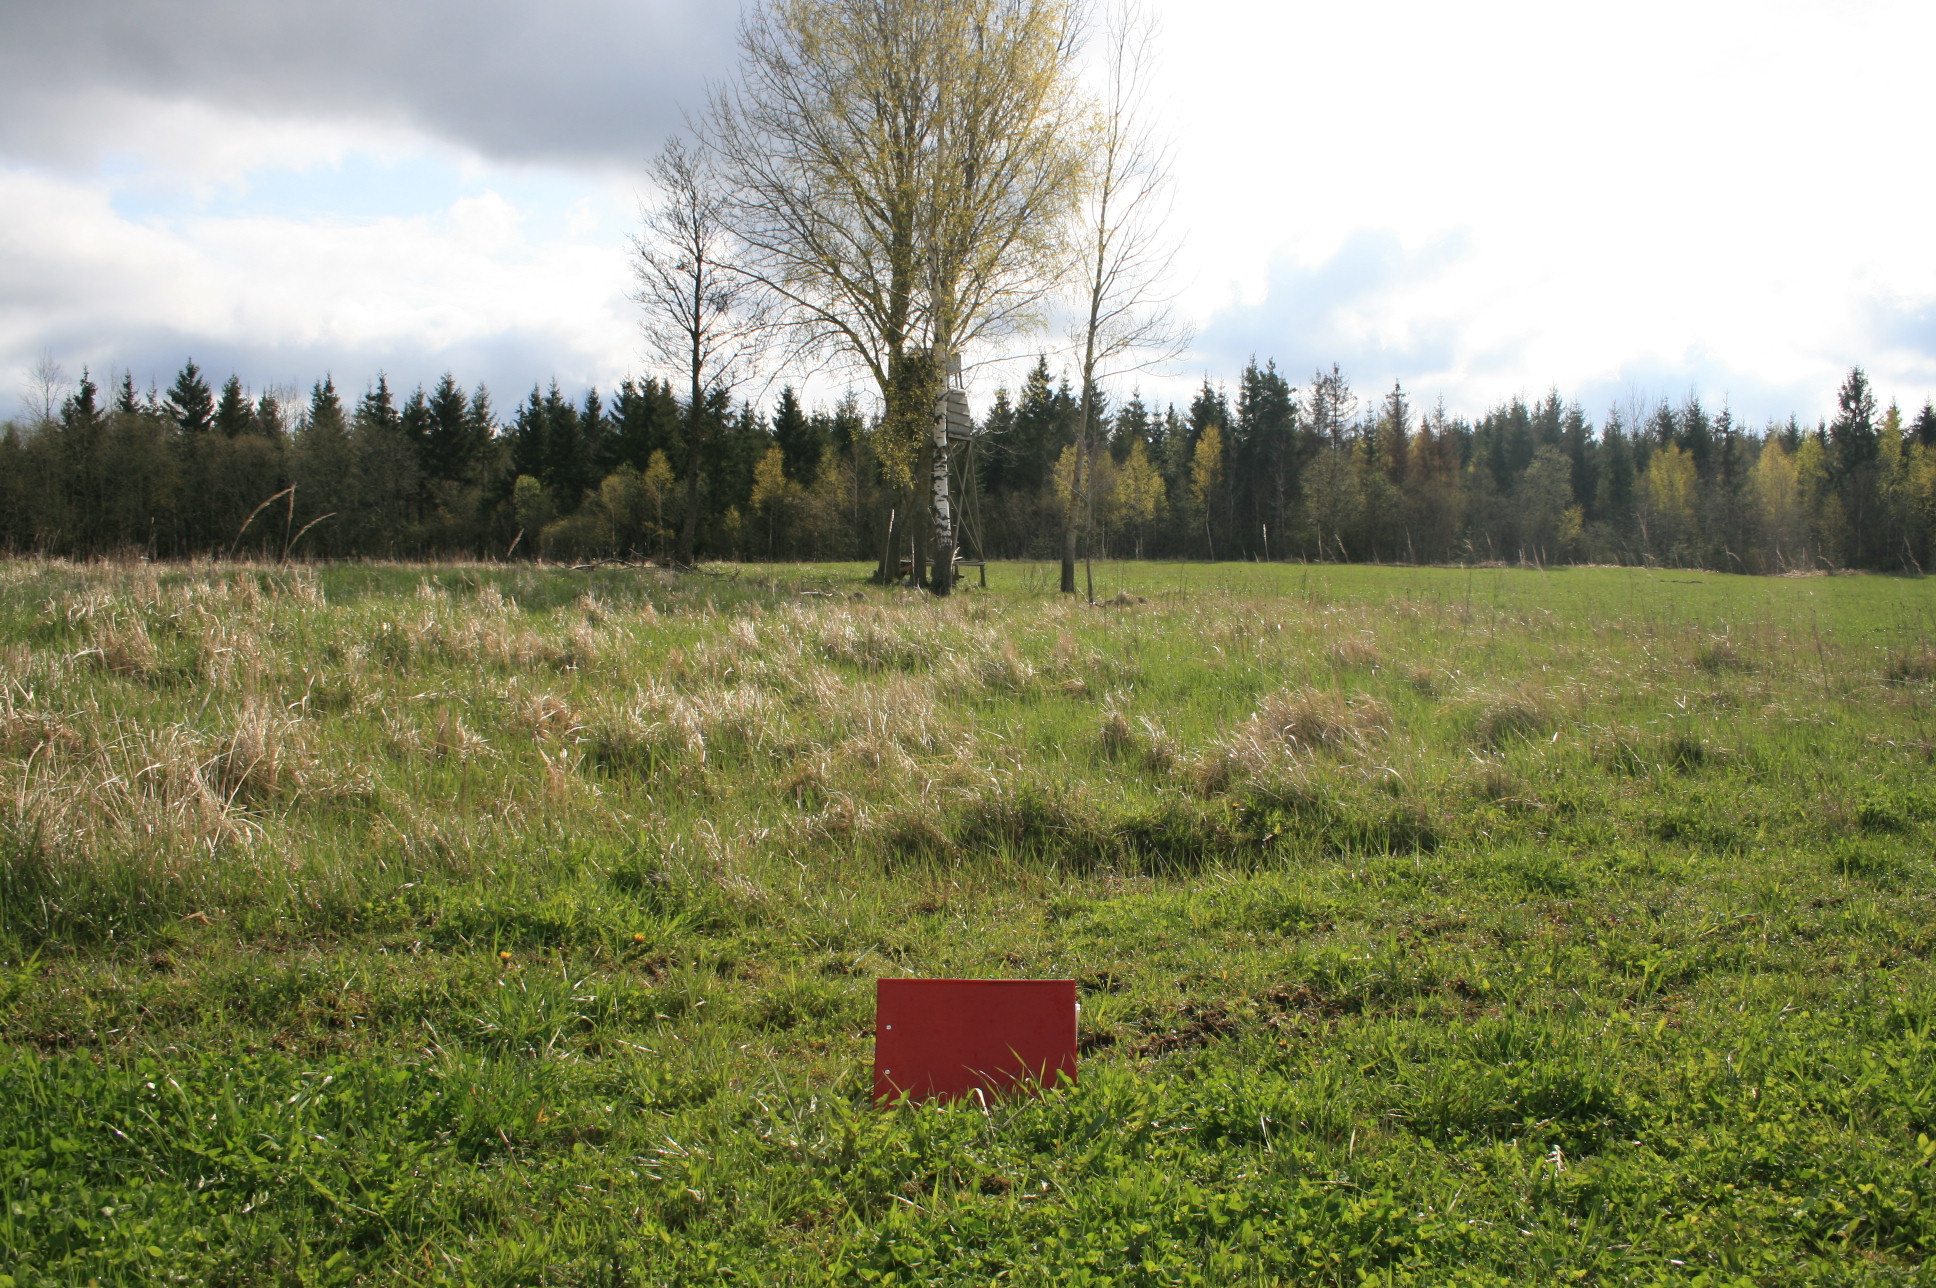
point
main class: Grassland
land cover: Grassland without tree/shrub cover
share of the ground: > 75 %
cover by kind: herbaceous plants 100 %
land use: Agriculture (excluding fallow land and kitchen gardens)
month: May
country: LT
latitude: 56.4025
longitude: 22.0247
